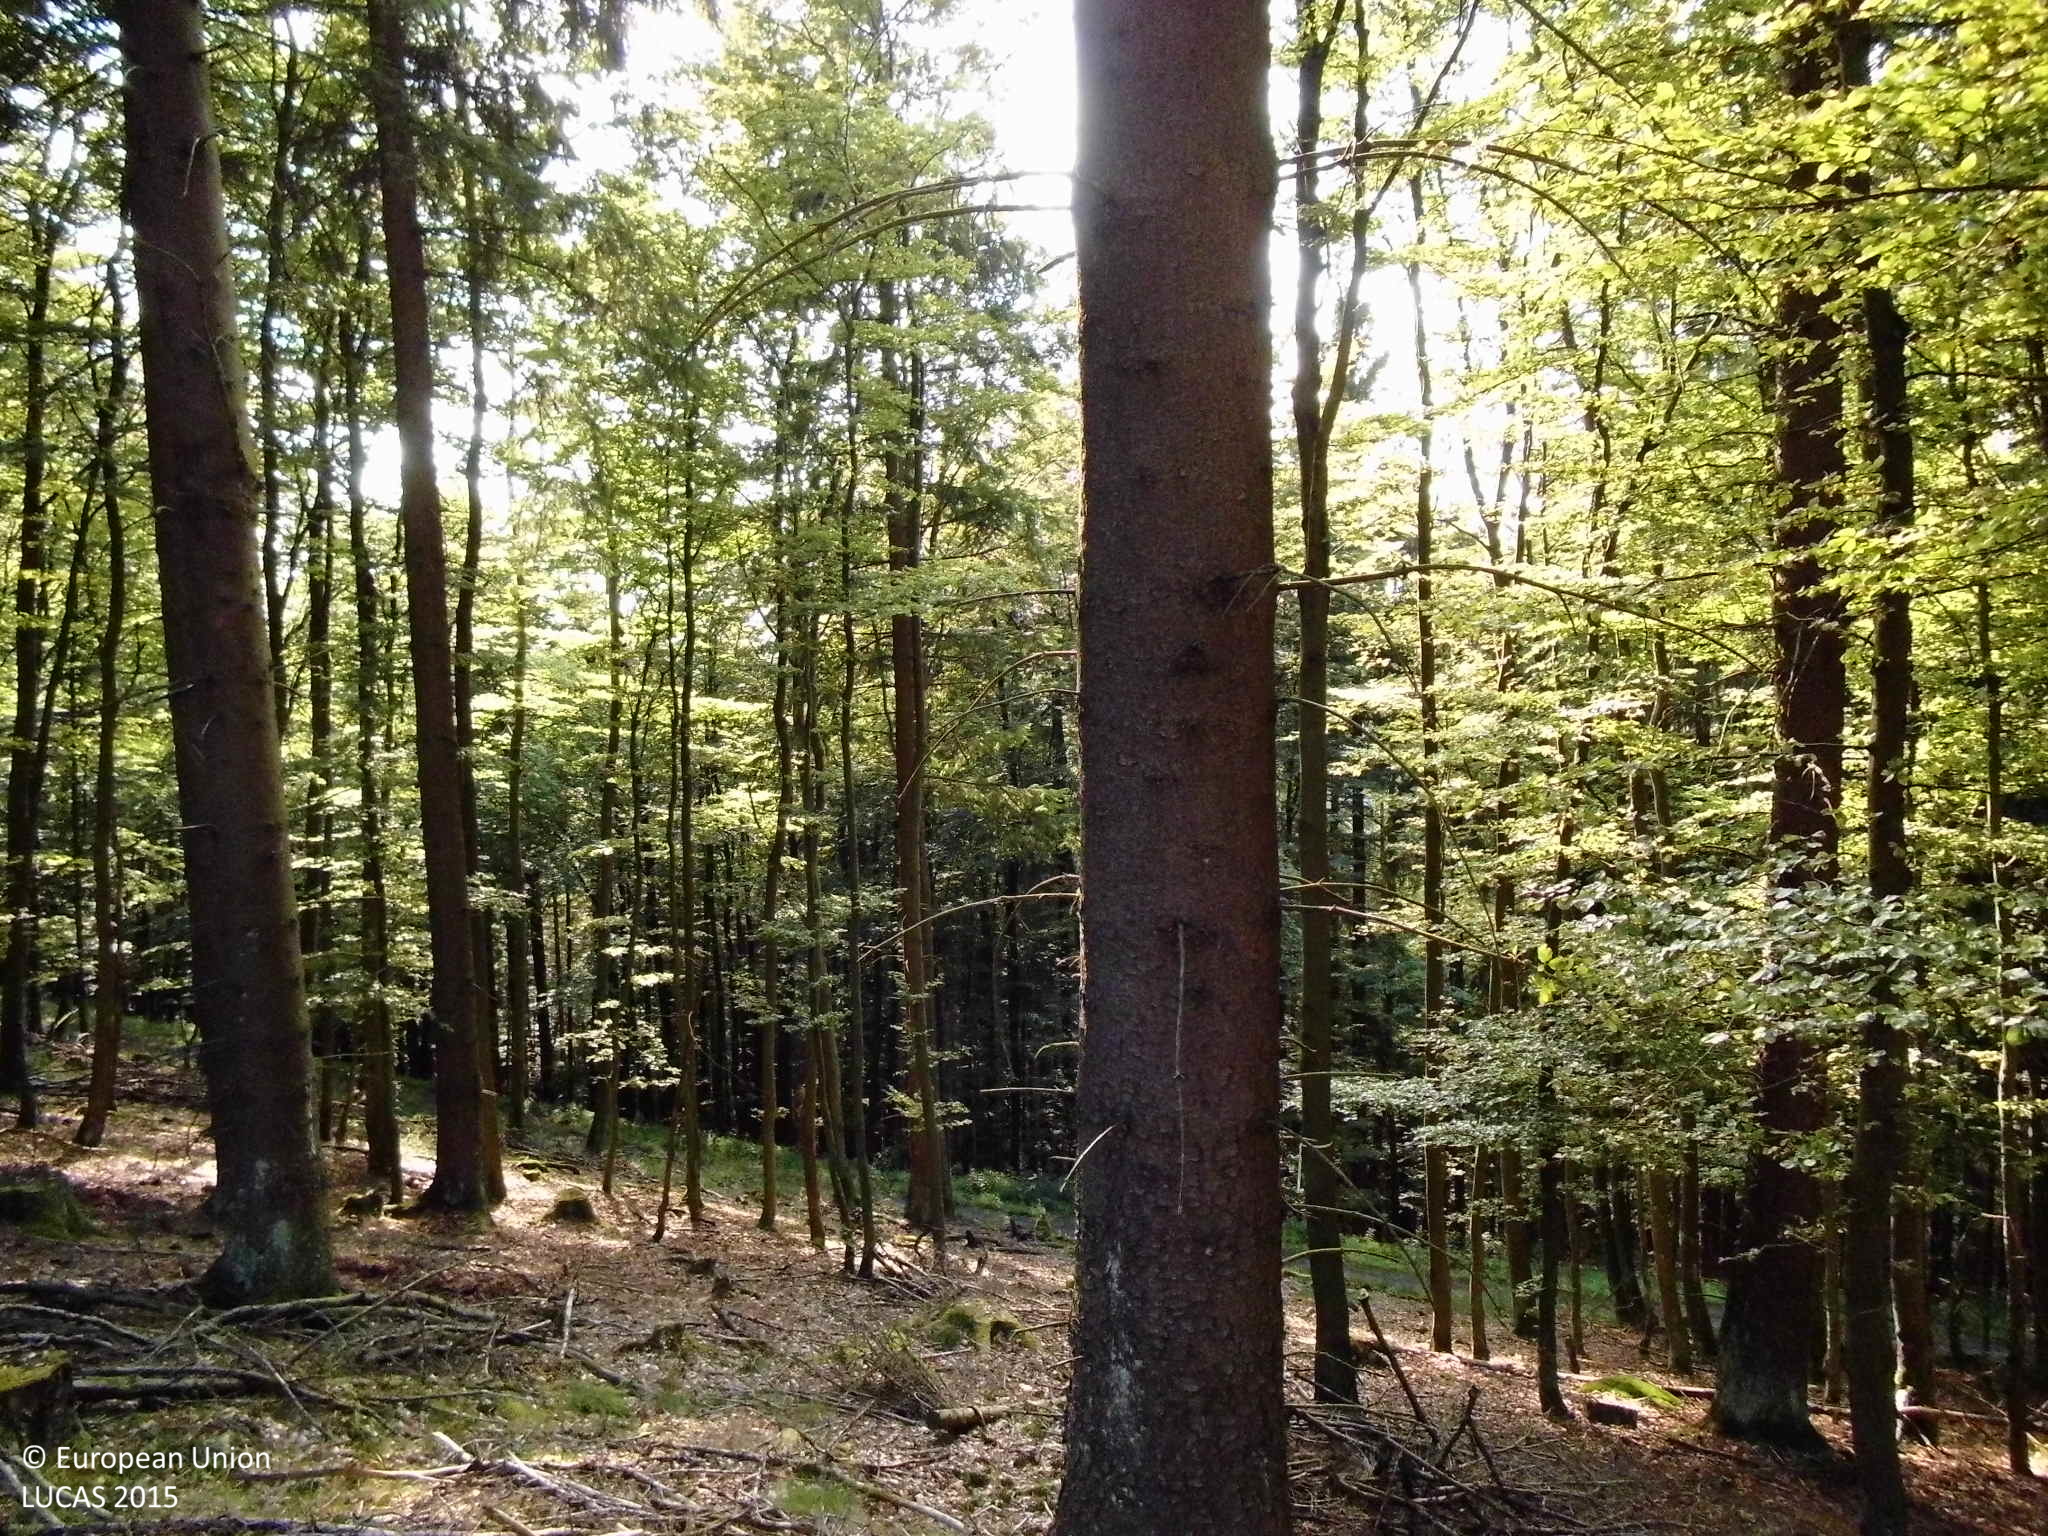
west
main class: Woodland
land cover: Spruce dominated mixed woodland
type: hemiboreal forest and nemoral coniferous forest and mixed broadleaved-coniferous forest
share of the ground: > 75 %
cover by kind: coniferous forest trees 40 %, broadleaved forest trees 40 %, herbaceous plants 10 %, lichens and mosses 5 %, unconsolidated bare surface 5 %
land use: Forestry
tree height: > 5 m
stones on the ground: < 10 %
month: August
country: DE
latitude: 51.1271
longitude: 8.4714
